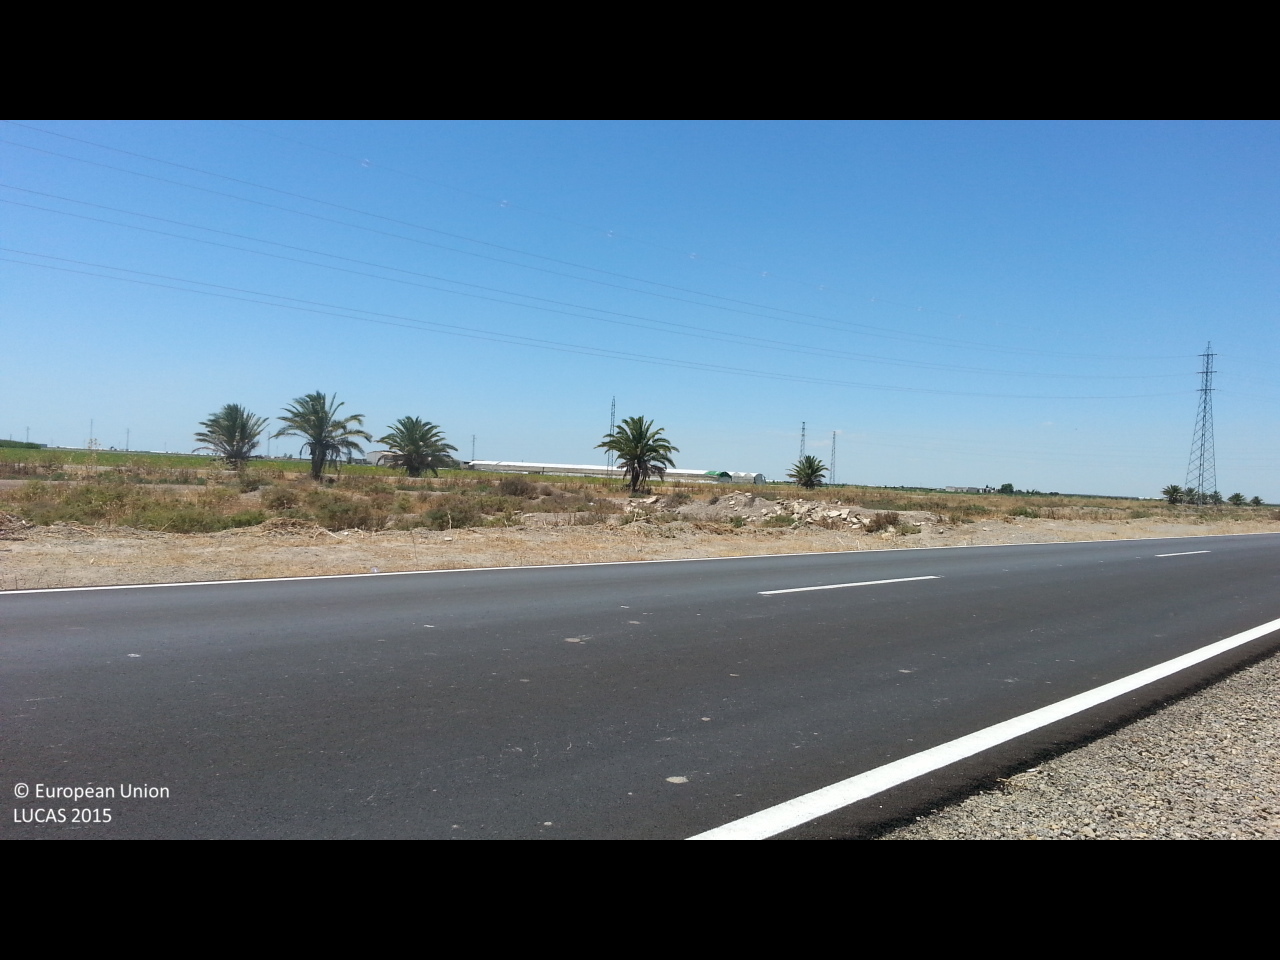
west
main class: Cropland
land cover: Maize
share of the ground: > 75 %
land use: Agriculture (excluding fallow land and kitchen gardens)
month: June
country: ES
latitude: 36.9620
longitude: -6.0663
